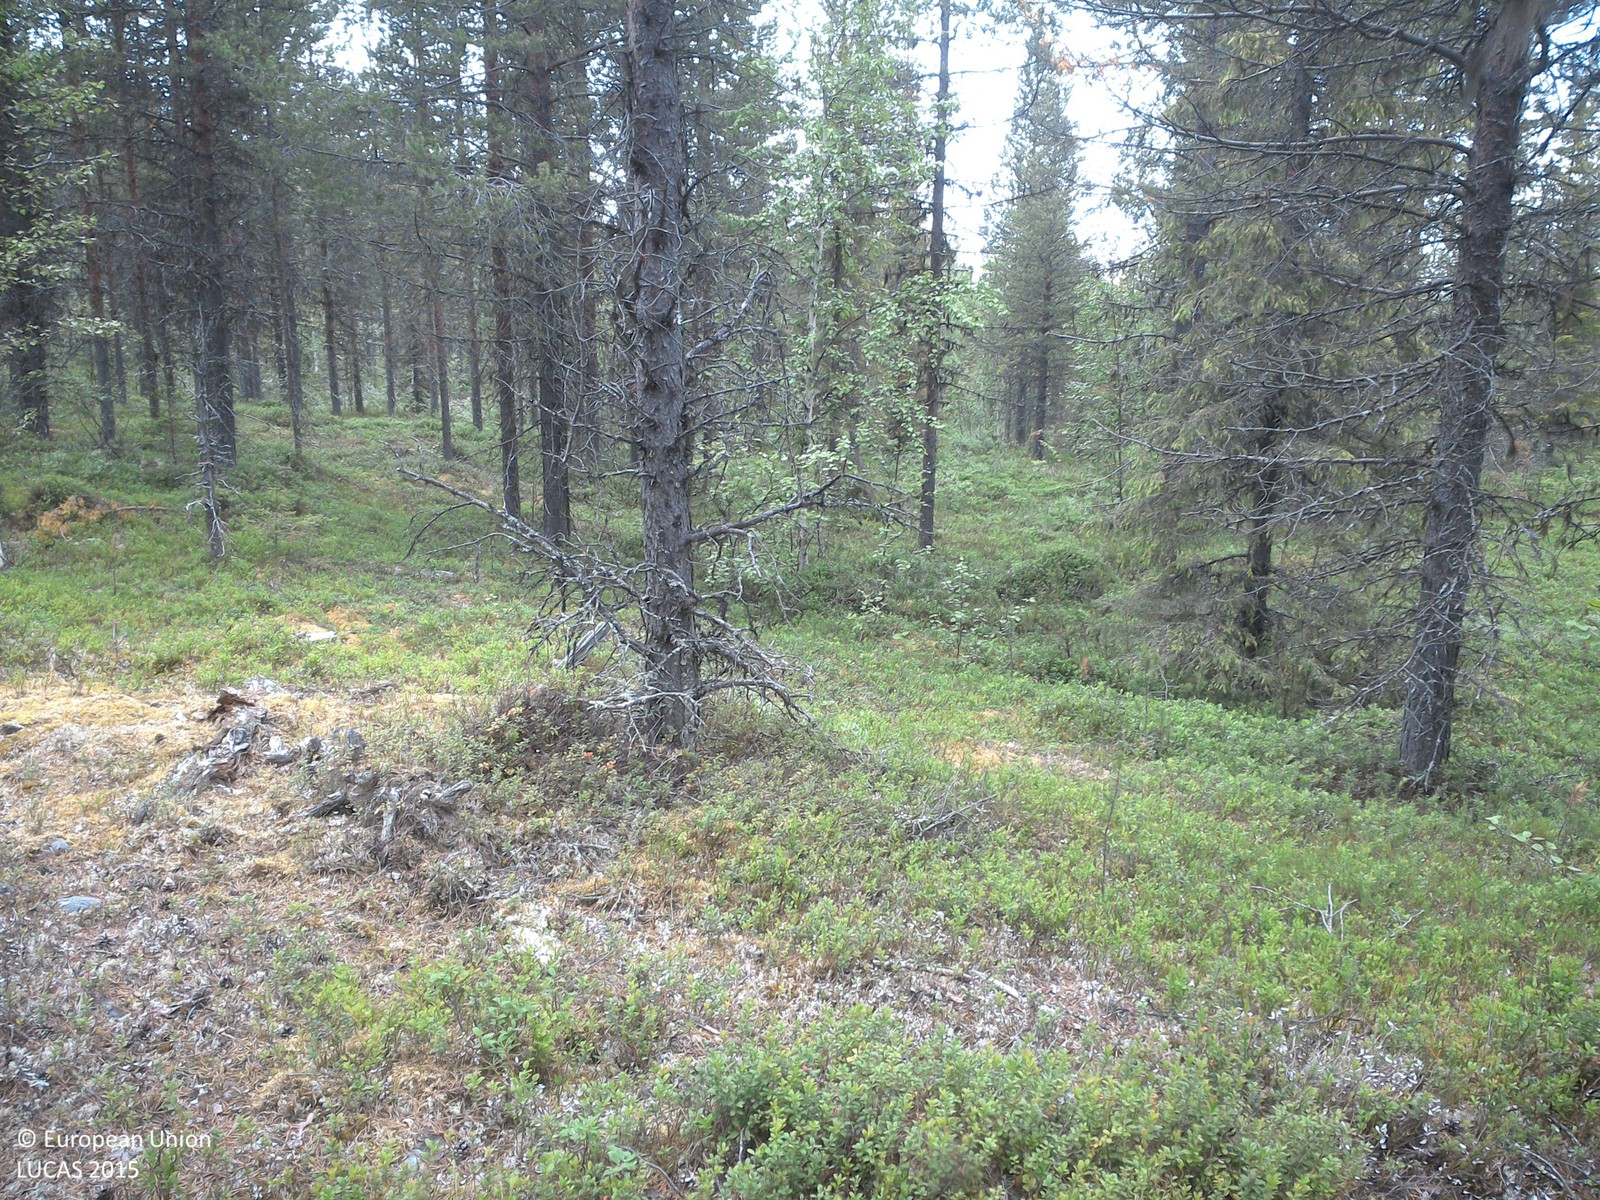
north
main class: Woodland
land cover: Pine dominated coniferous woodland
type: boreal forest
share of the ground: 25 - 50 %
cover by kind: shrubs 55 %, coniferous forest trees 30 %, lichens and mosses 10 %, broadleaved forest trees 5 %
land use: Forestry
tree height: > 5 m
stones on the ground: 25 - 50 %
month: July
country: SE
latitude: 67.5669
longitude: 22.0936
